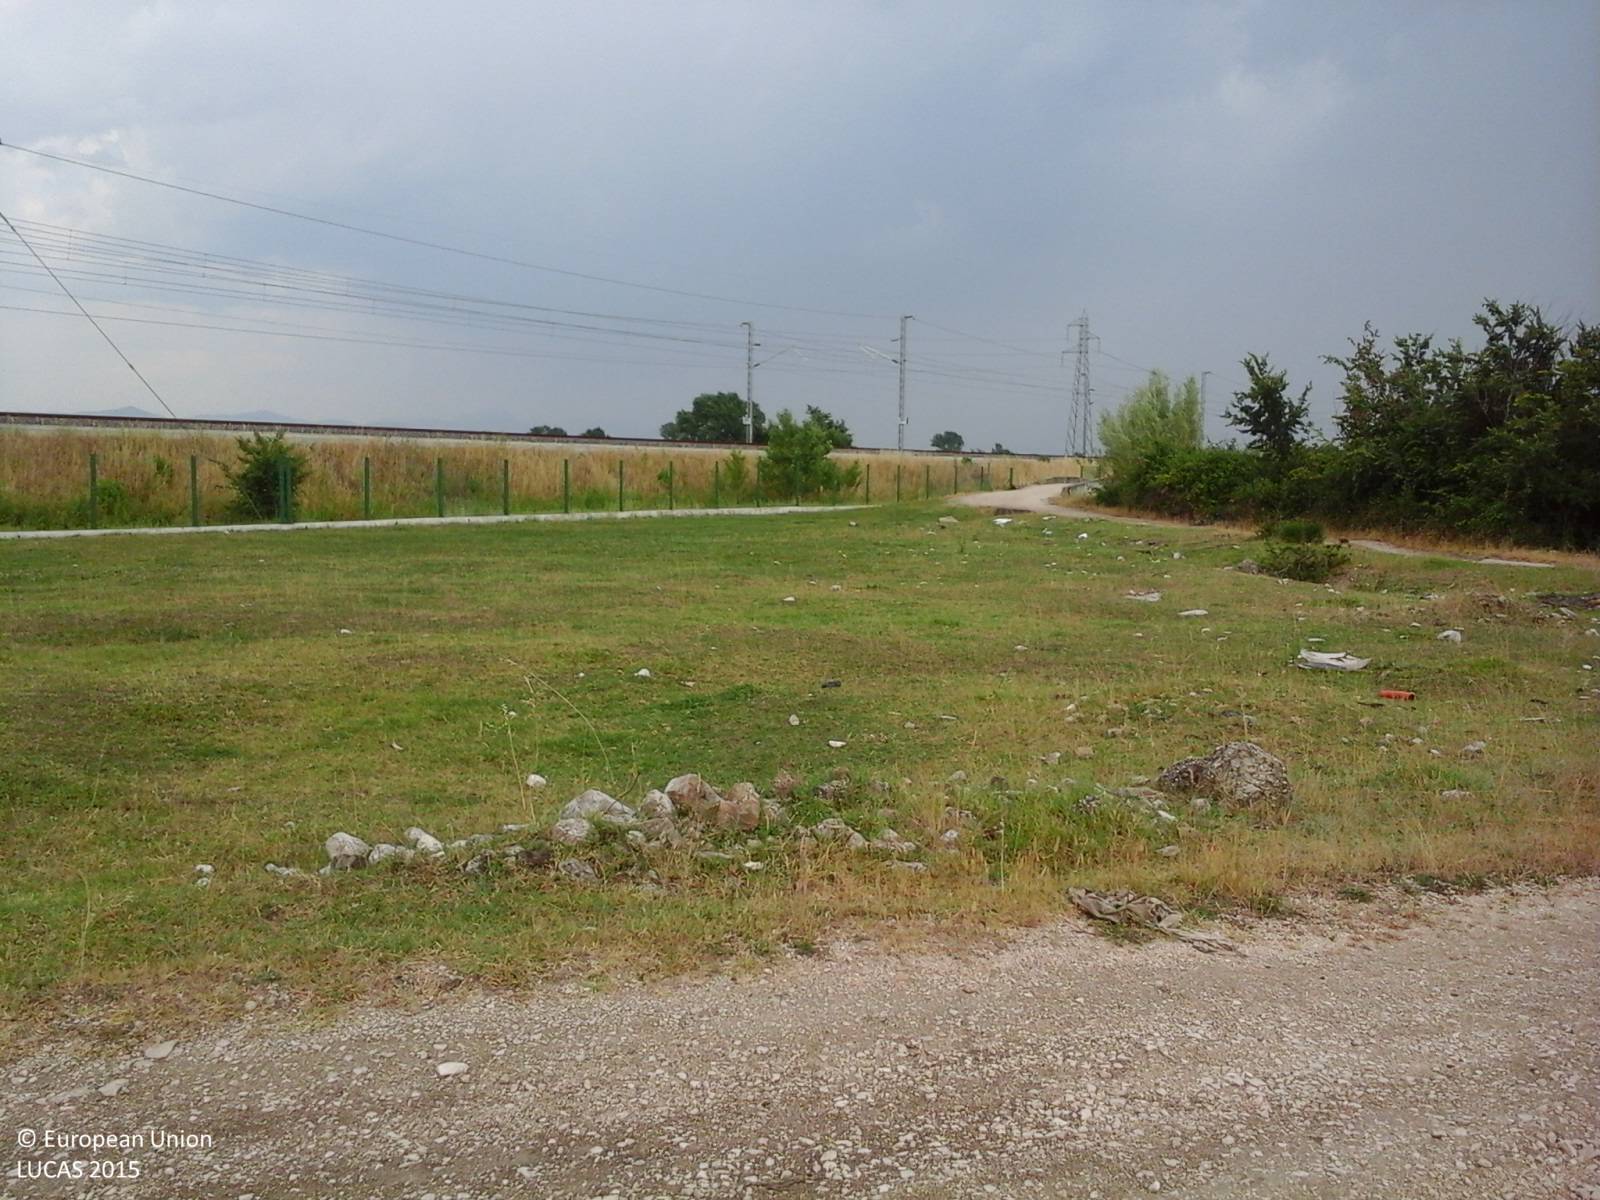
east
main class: Cropland
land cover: Barley
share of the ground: > 75 %
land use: Agriculture (excluding fallow land and kitchen gardens)
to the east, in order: Barley; Abandoned hedges; Ditches and canals; Grass margins; Tracks; Grass margins; Spontaneously vegetated surfaces; Railways; Electric lines; Grass margins; Tracks; Grass margins; Ditches and canals; Temporary grasslands; Electric lines; Temporary grasslands; Tomatoes
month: June
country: IT
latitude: 41.0838
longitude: 14.1852
